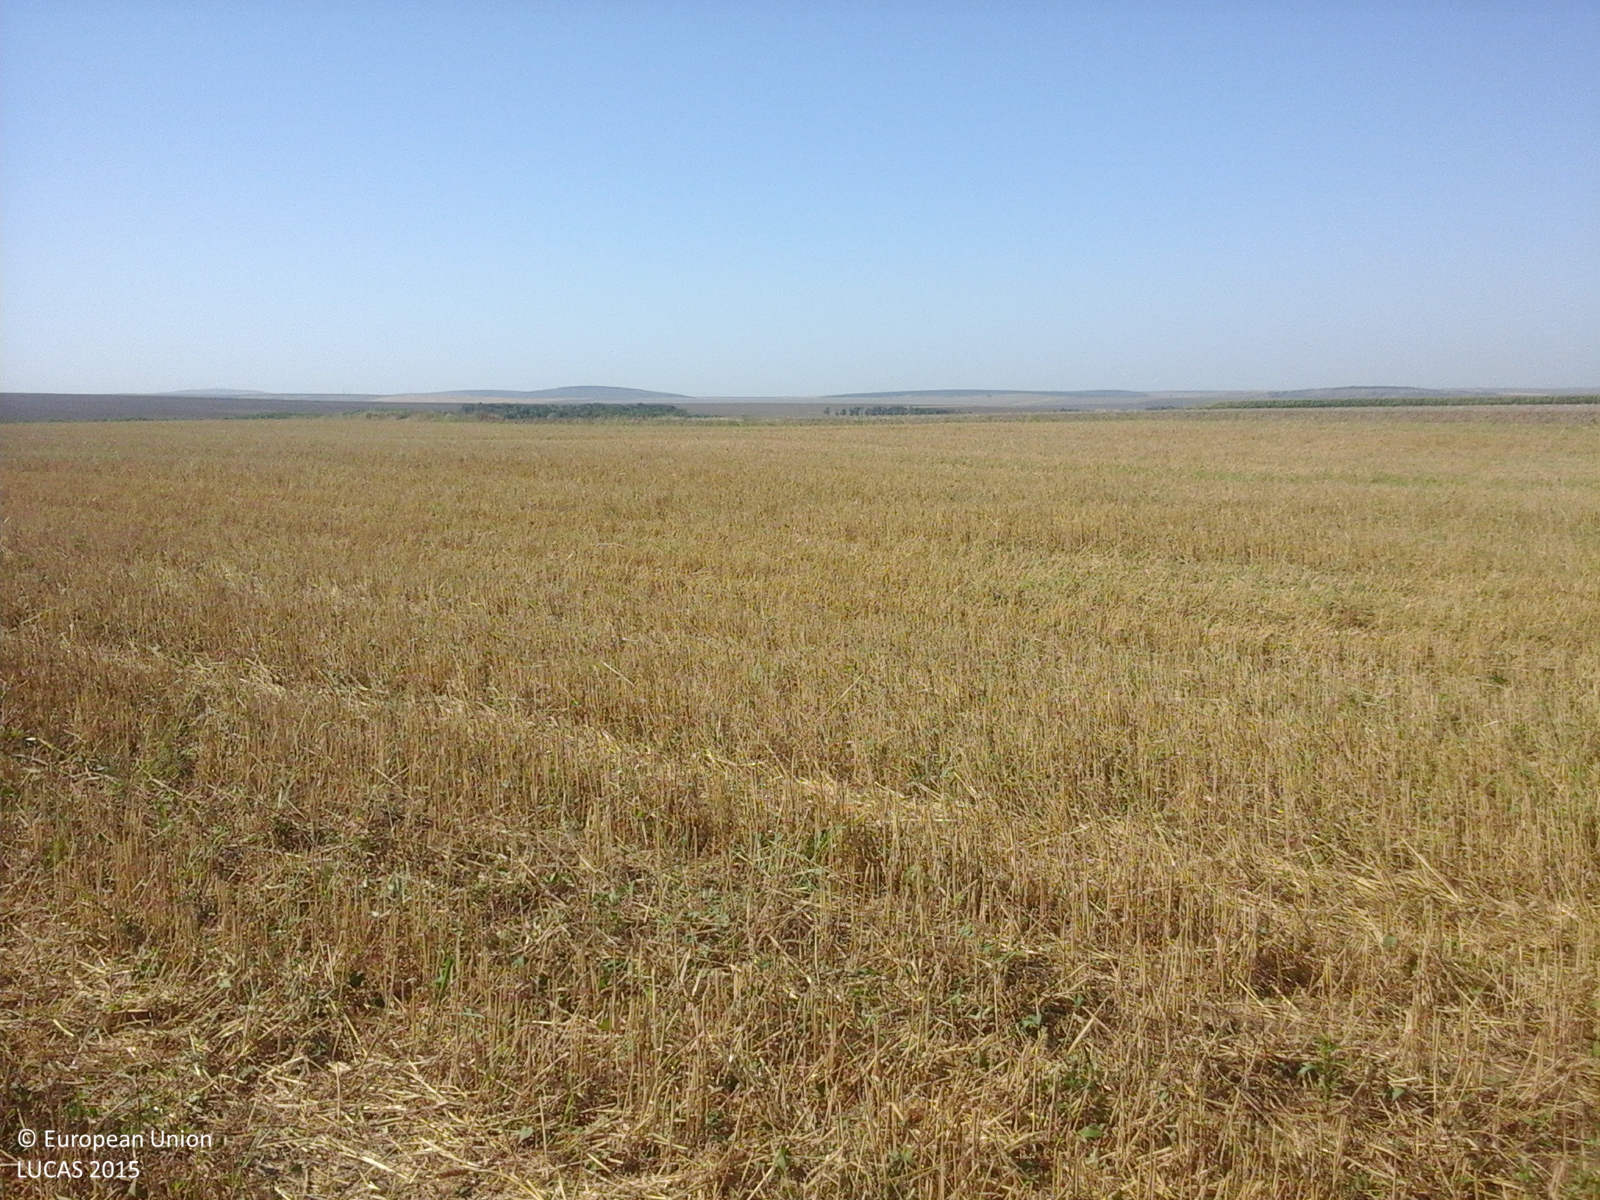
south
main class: Cropland
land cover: Common wheat
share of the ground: > 75 %
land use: Agriculture (excluding fallow land and kitchen gardens)
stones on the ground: < 10 %
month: August
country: RO
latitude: 44.6508
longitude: 28.1583
